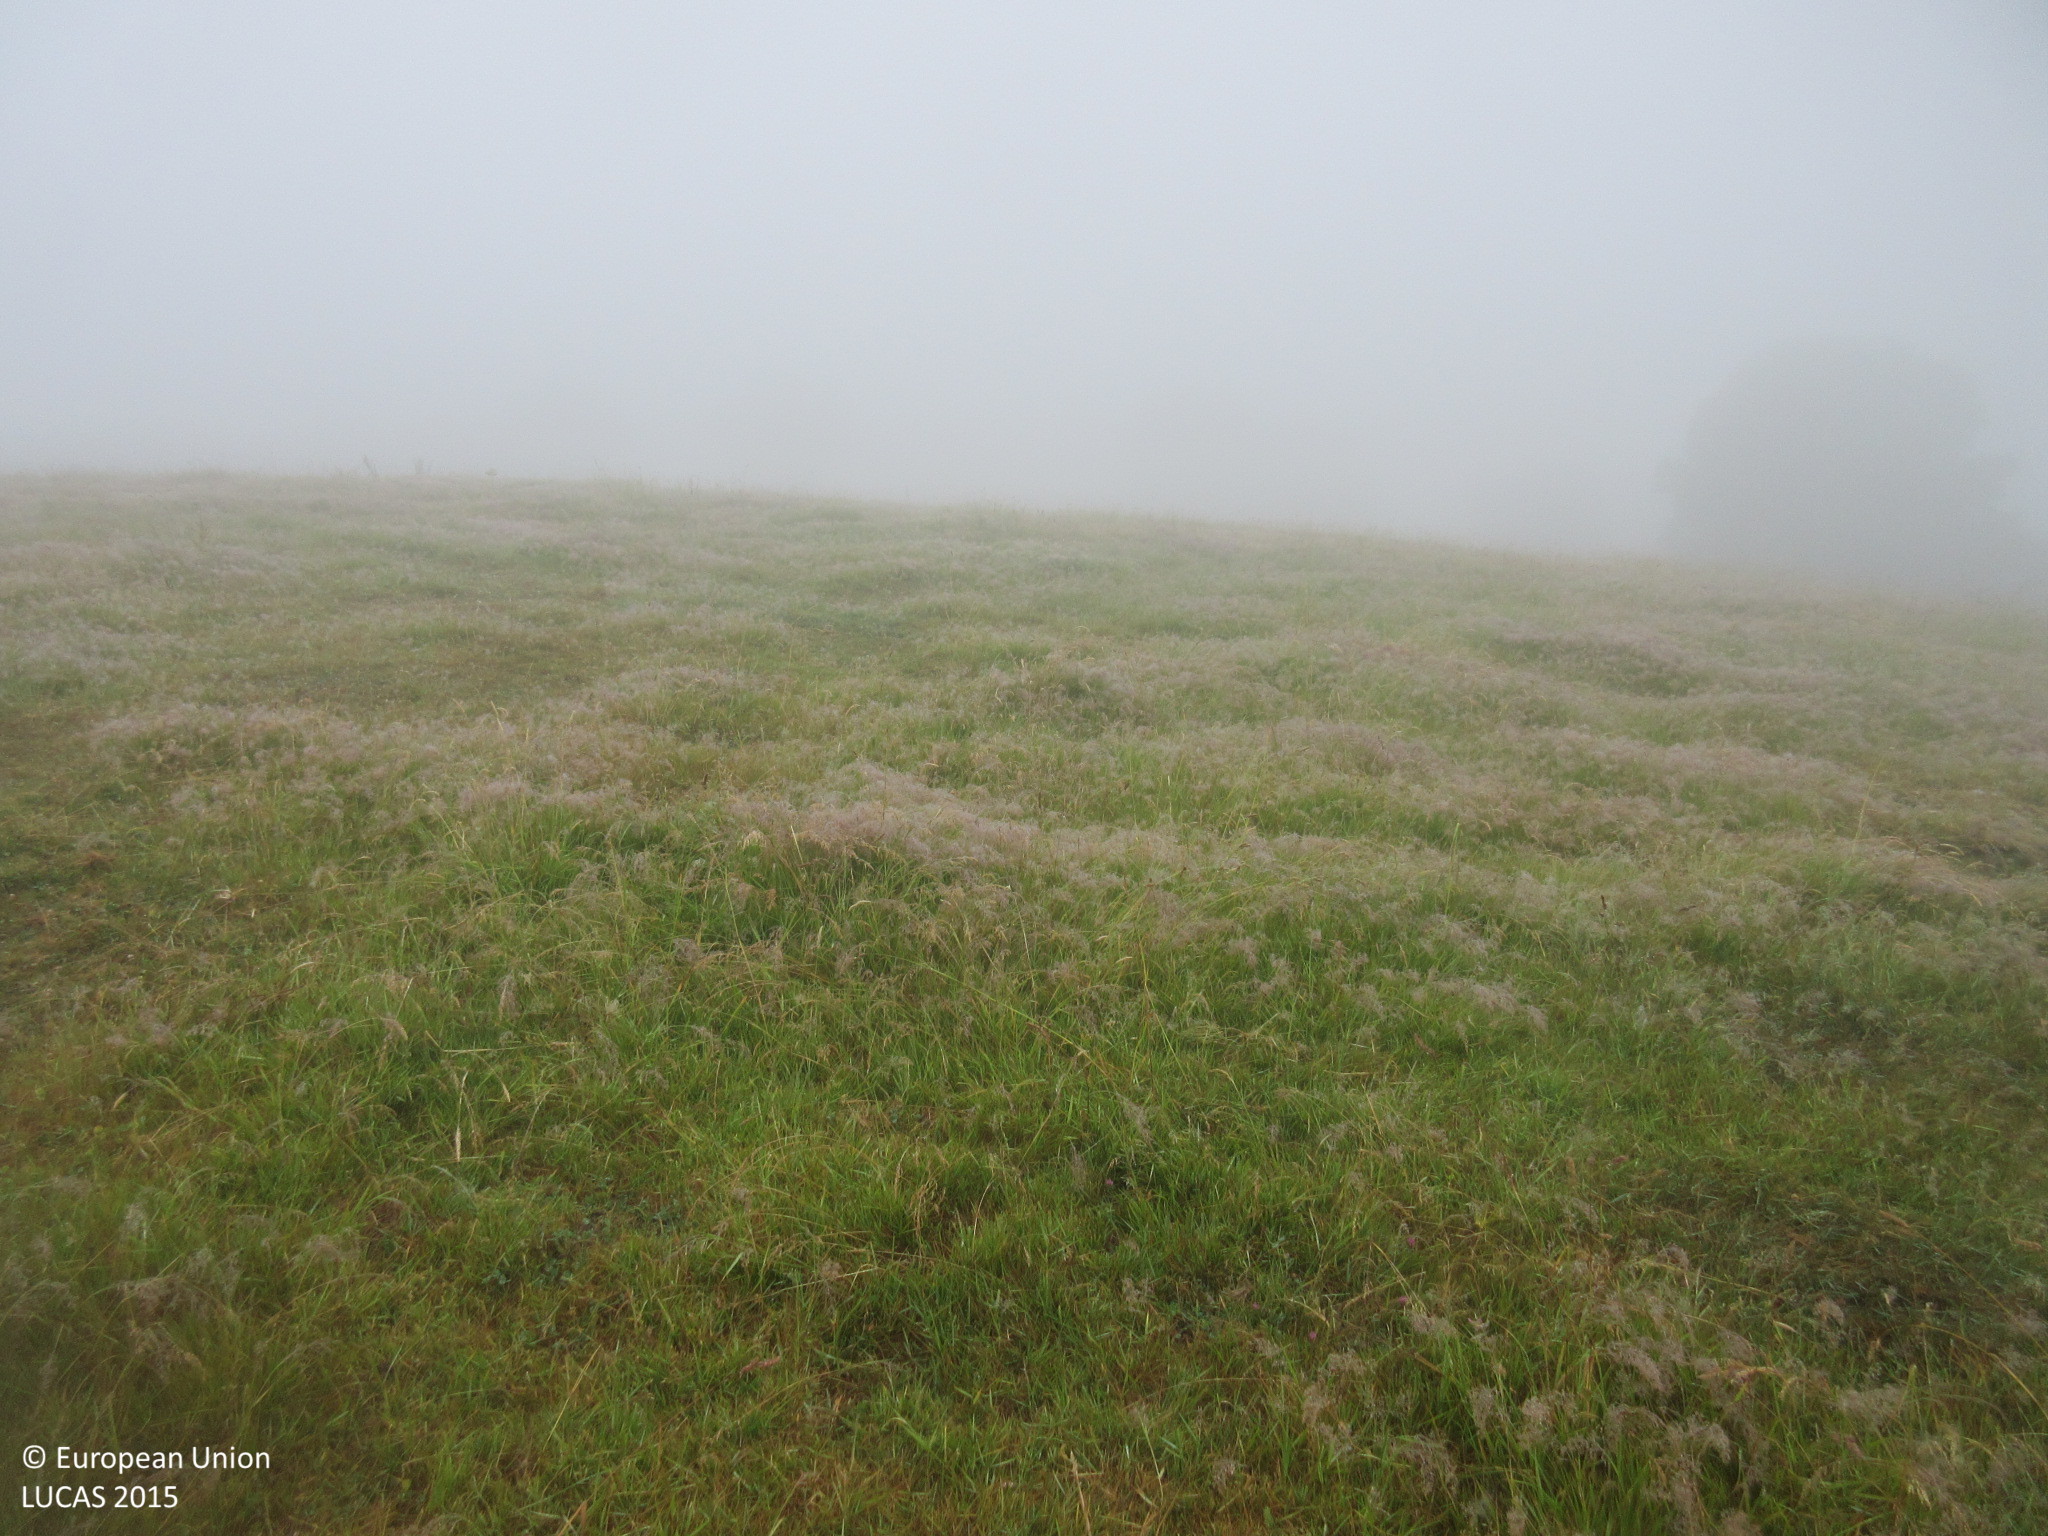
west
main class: Grassland
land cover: Grassland without tree/shrub cover
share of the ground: > 75 %
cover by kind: herbaceous plants 100 %
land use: Agriculture (excluding fallow land and kitchen gardens)
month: June
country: ES
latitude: 43.2399
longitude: -7.0483
